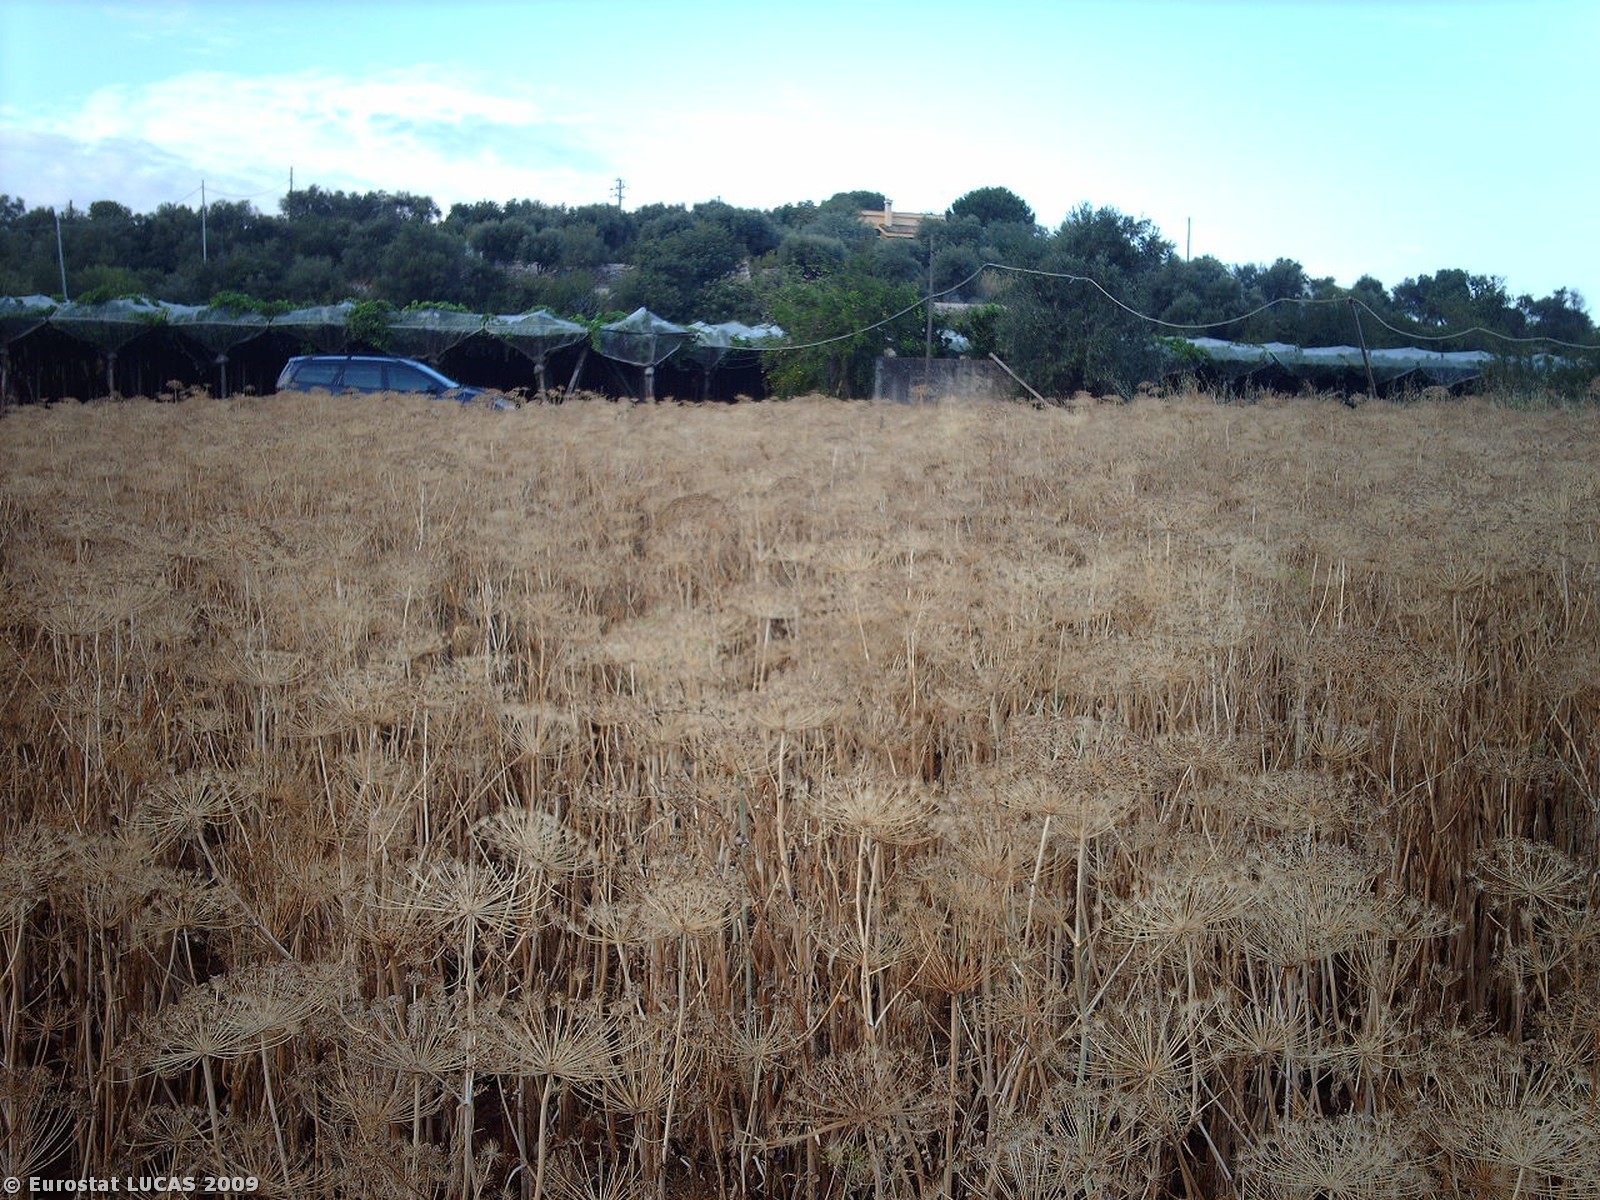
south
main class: Grassland
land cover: Spontaneously vegetated surfaces
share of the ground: > 75 %
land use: Fallow land
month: August
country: IT
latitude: 41.0279
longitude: 17.0794
